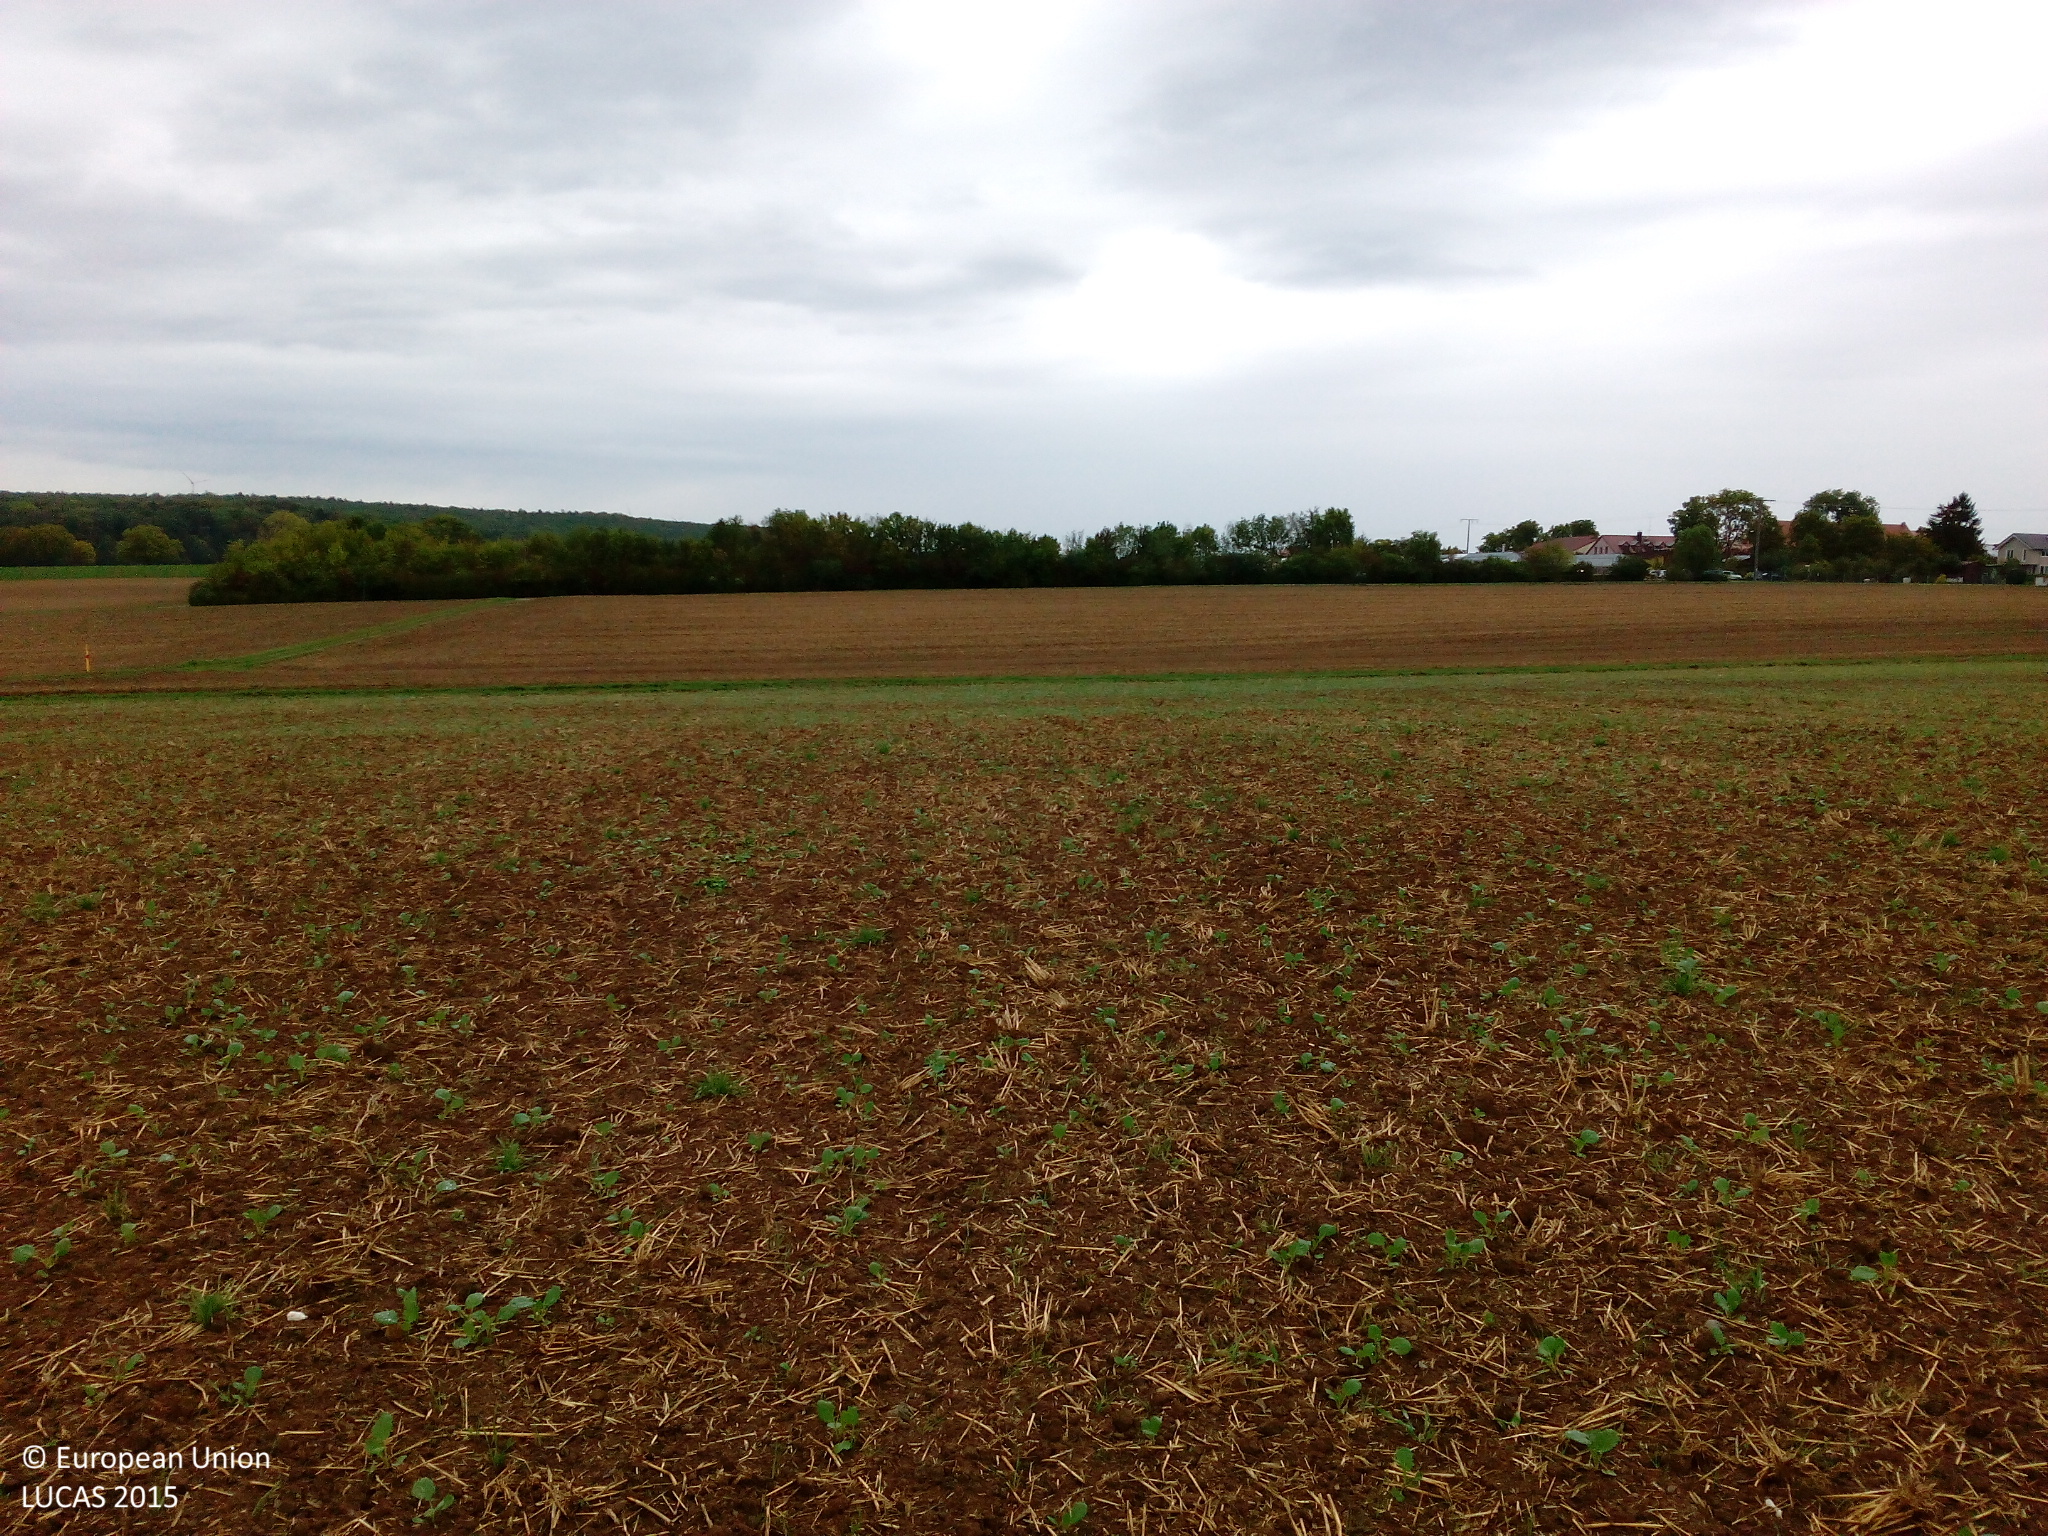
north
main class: Cropland
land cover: Common wheat
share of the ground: 10 - 25 %
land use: Agriculture (excluding fallow land and kitchen gardens)
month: September
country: DE
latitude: 49.8425
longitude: 9.9027
